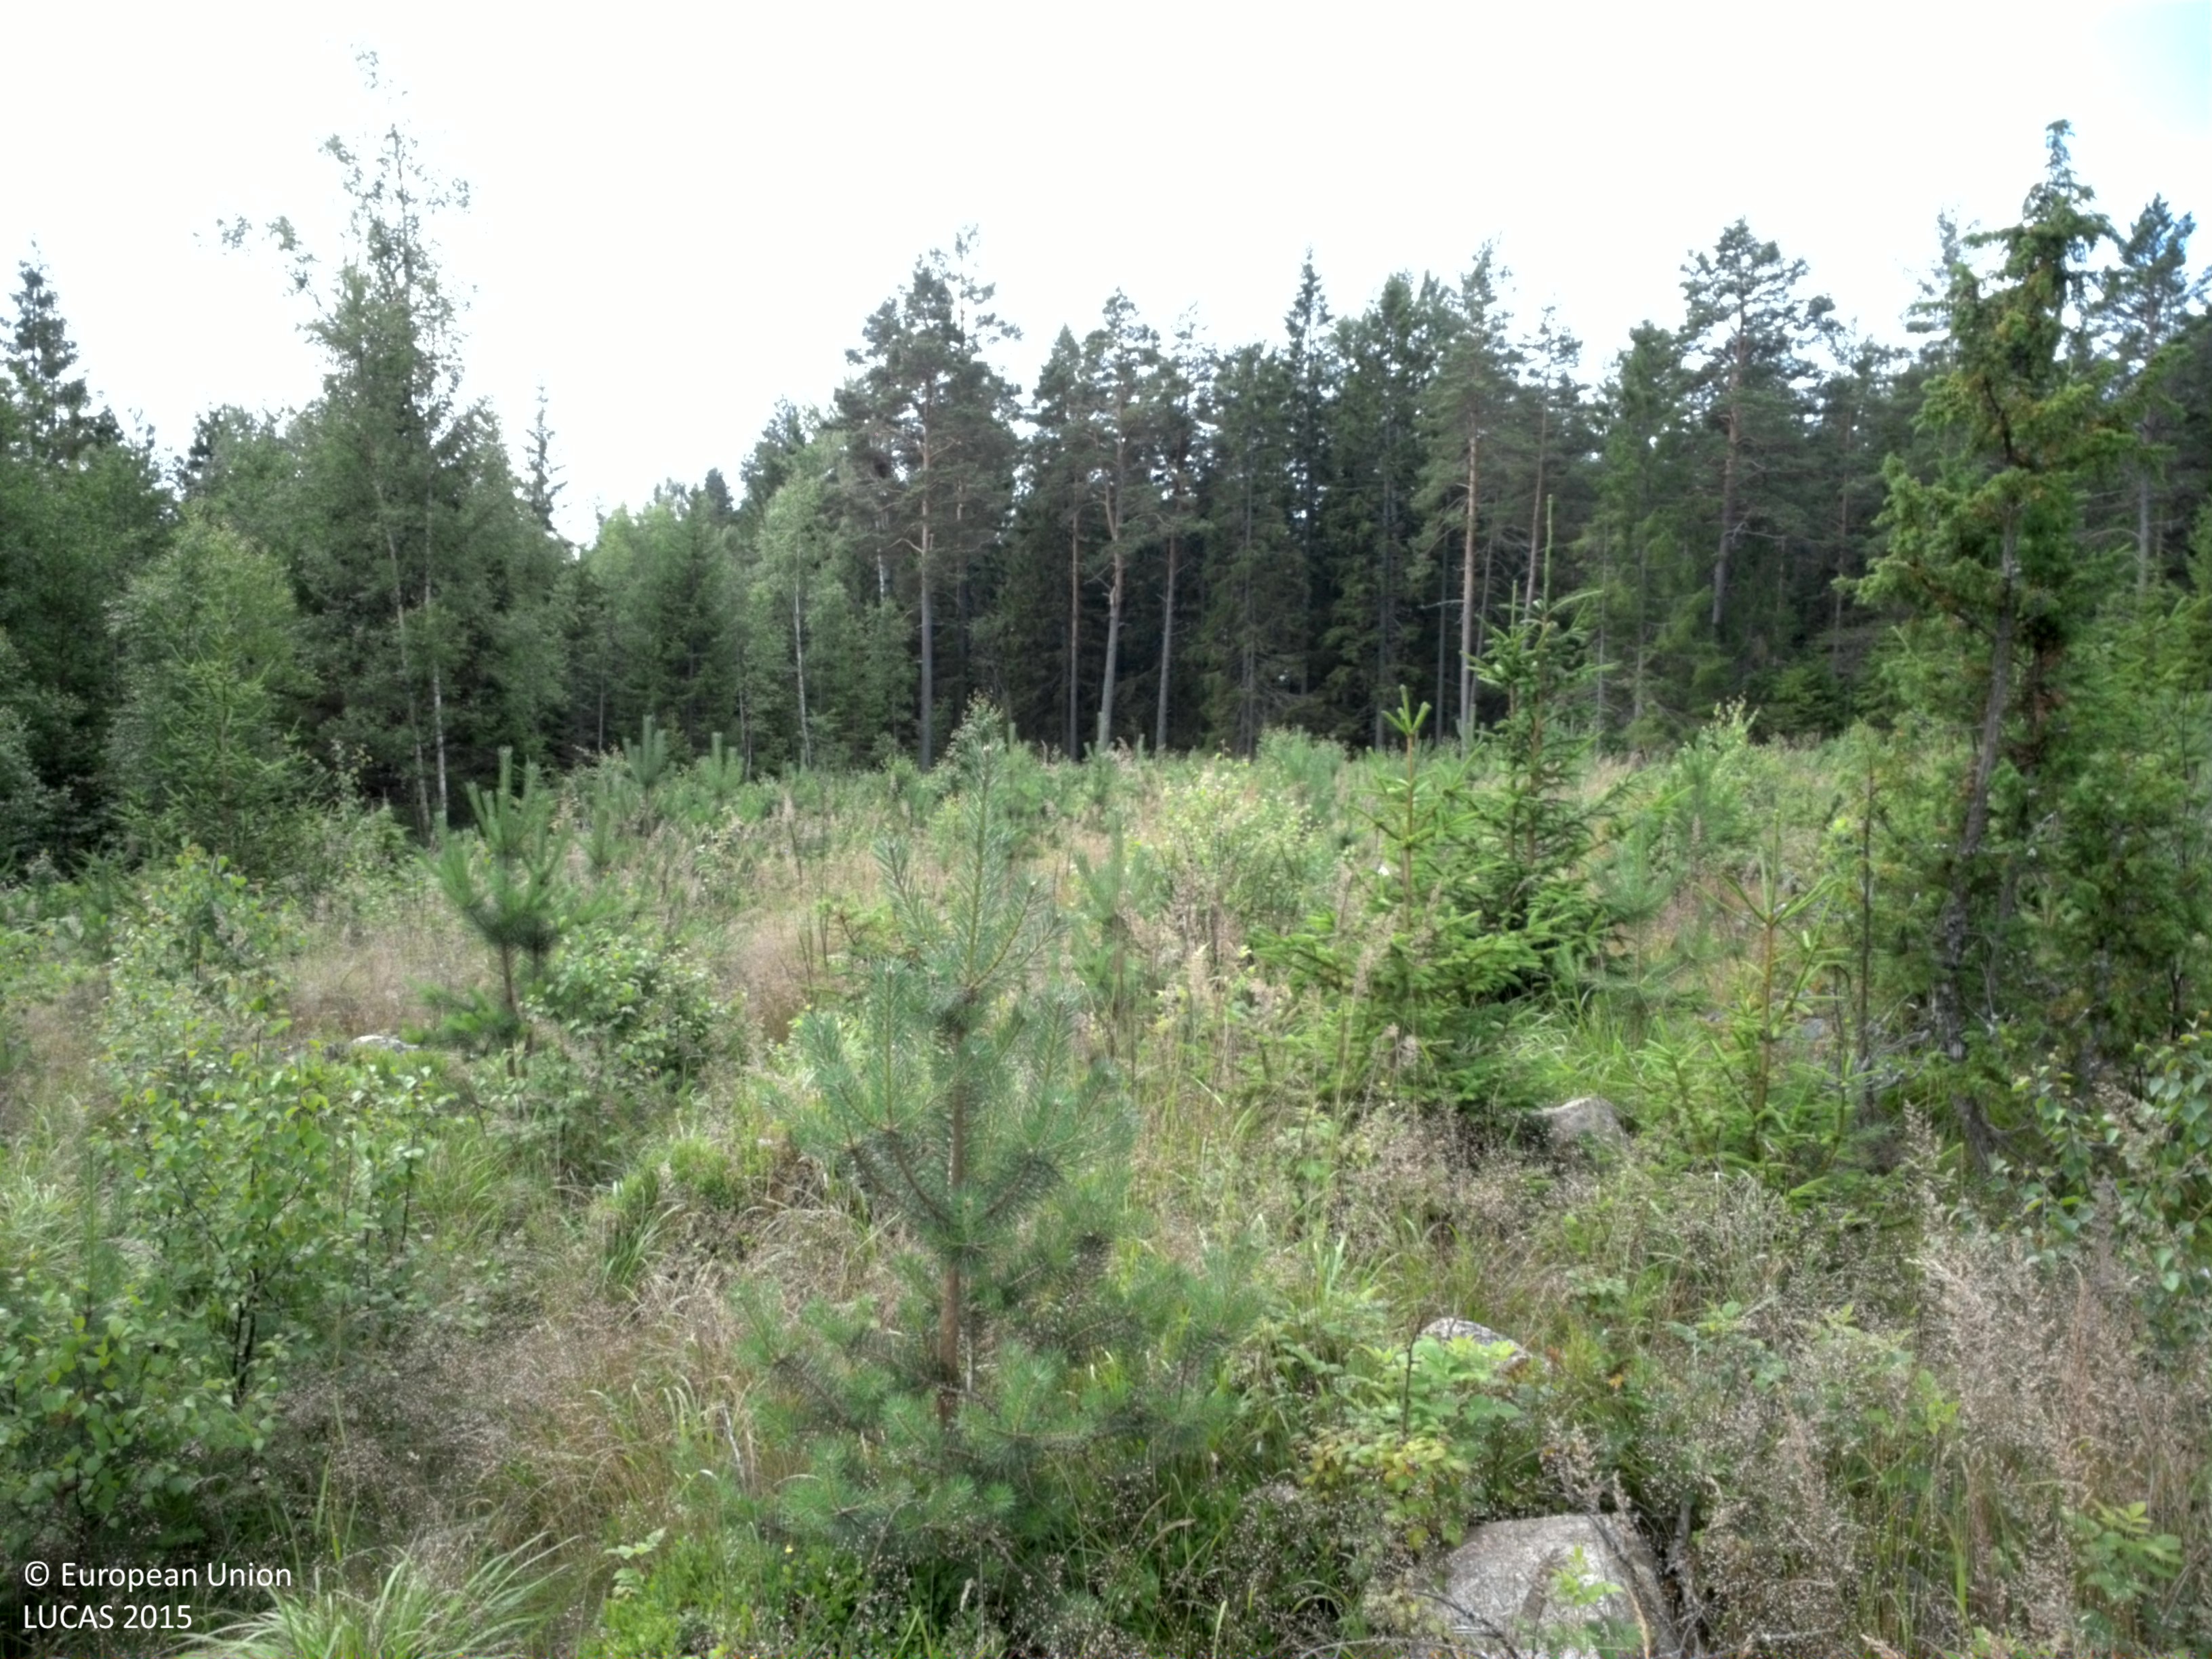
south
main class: Woodland
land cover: Pine dominated mixed woodland
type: boreal forest
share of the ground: 25 - 50 %
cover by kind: herbaceous plants 45 %, coniferous forest trees 30 %, lichens and mosses 15 %, broadleaved forest trees 10 %
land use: Forestry
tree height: < 5 m
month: July
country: SE
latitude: 60.0204
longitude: 18.7001
